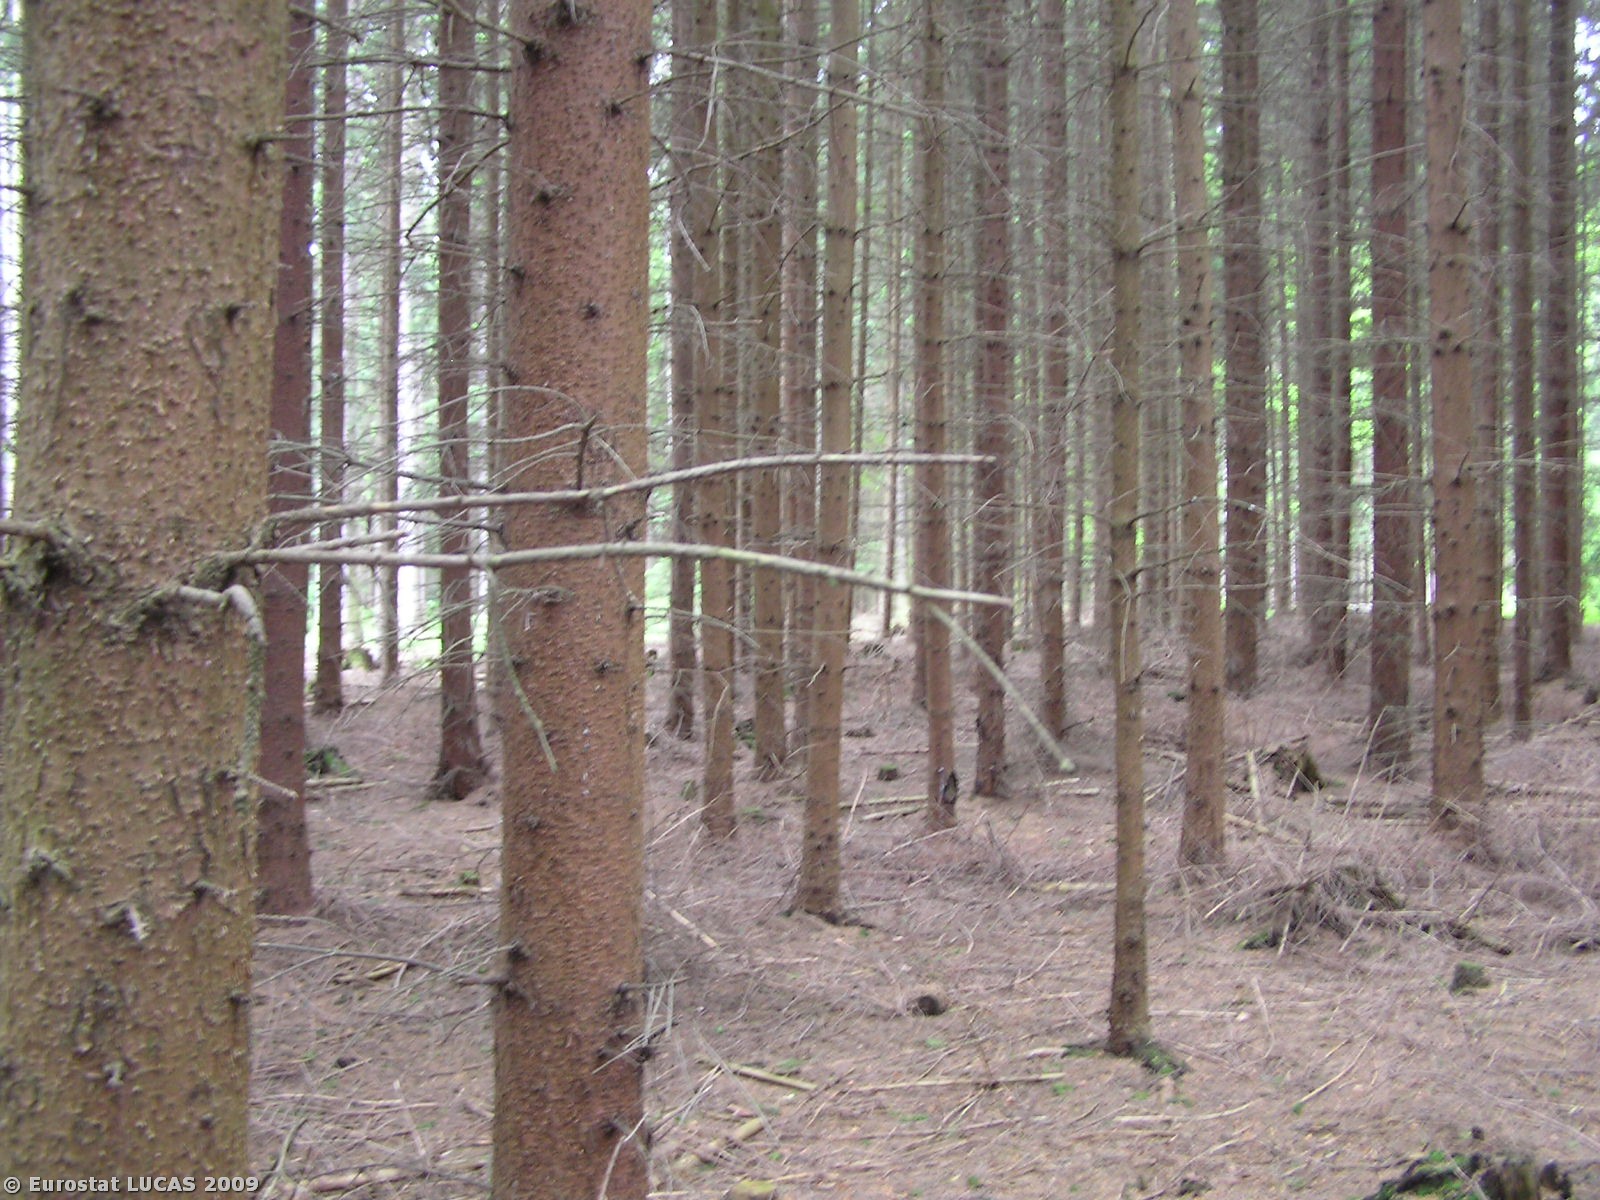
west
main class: Woodland
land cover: Coniferous woodland
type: hemiboreal forest and nemoral coniferous forest and mixed broadleaved-coniferous forest
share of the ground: > 75 %
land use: Forestry
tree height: > 5 m
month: May
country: CZ
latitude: 49.3192
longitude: 14.9686
